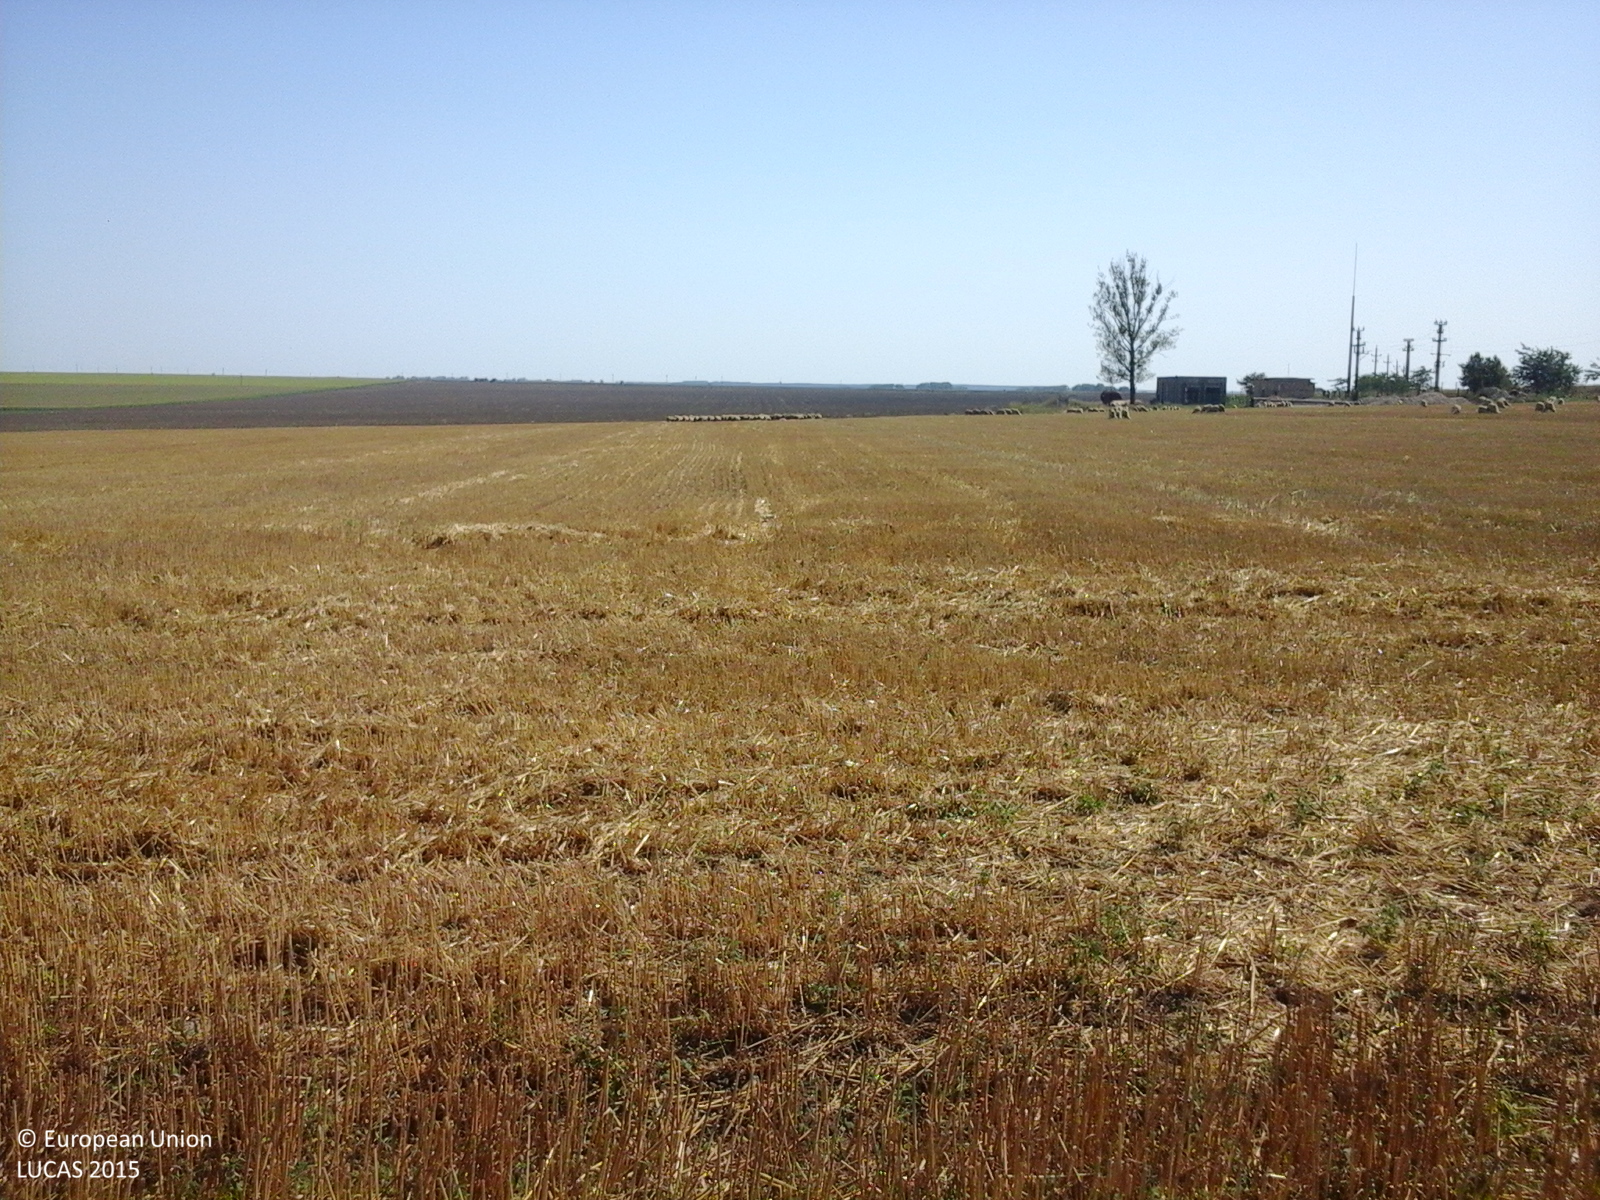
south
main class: Cropland
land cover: Common wheat
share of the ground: 25 - 50 %
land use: Agriculture (excluding fallow land and kitchen gardens)
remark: Harvested field
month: August
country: RO
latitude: 44.4108
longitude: 28.4684
